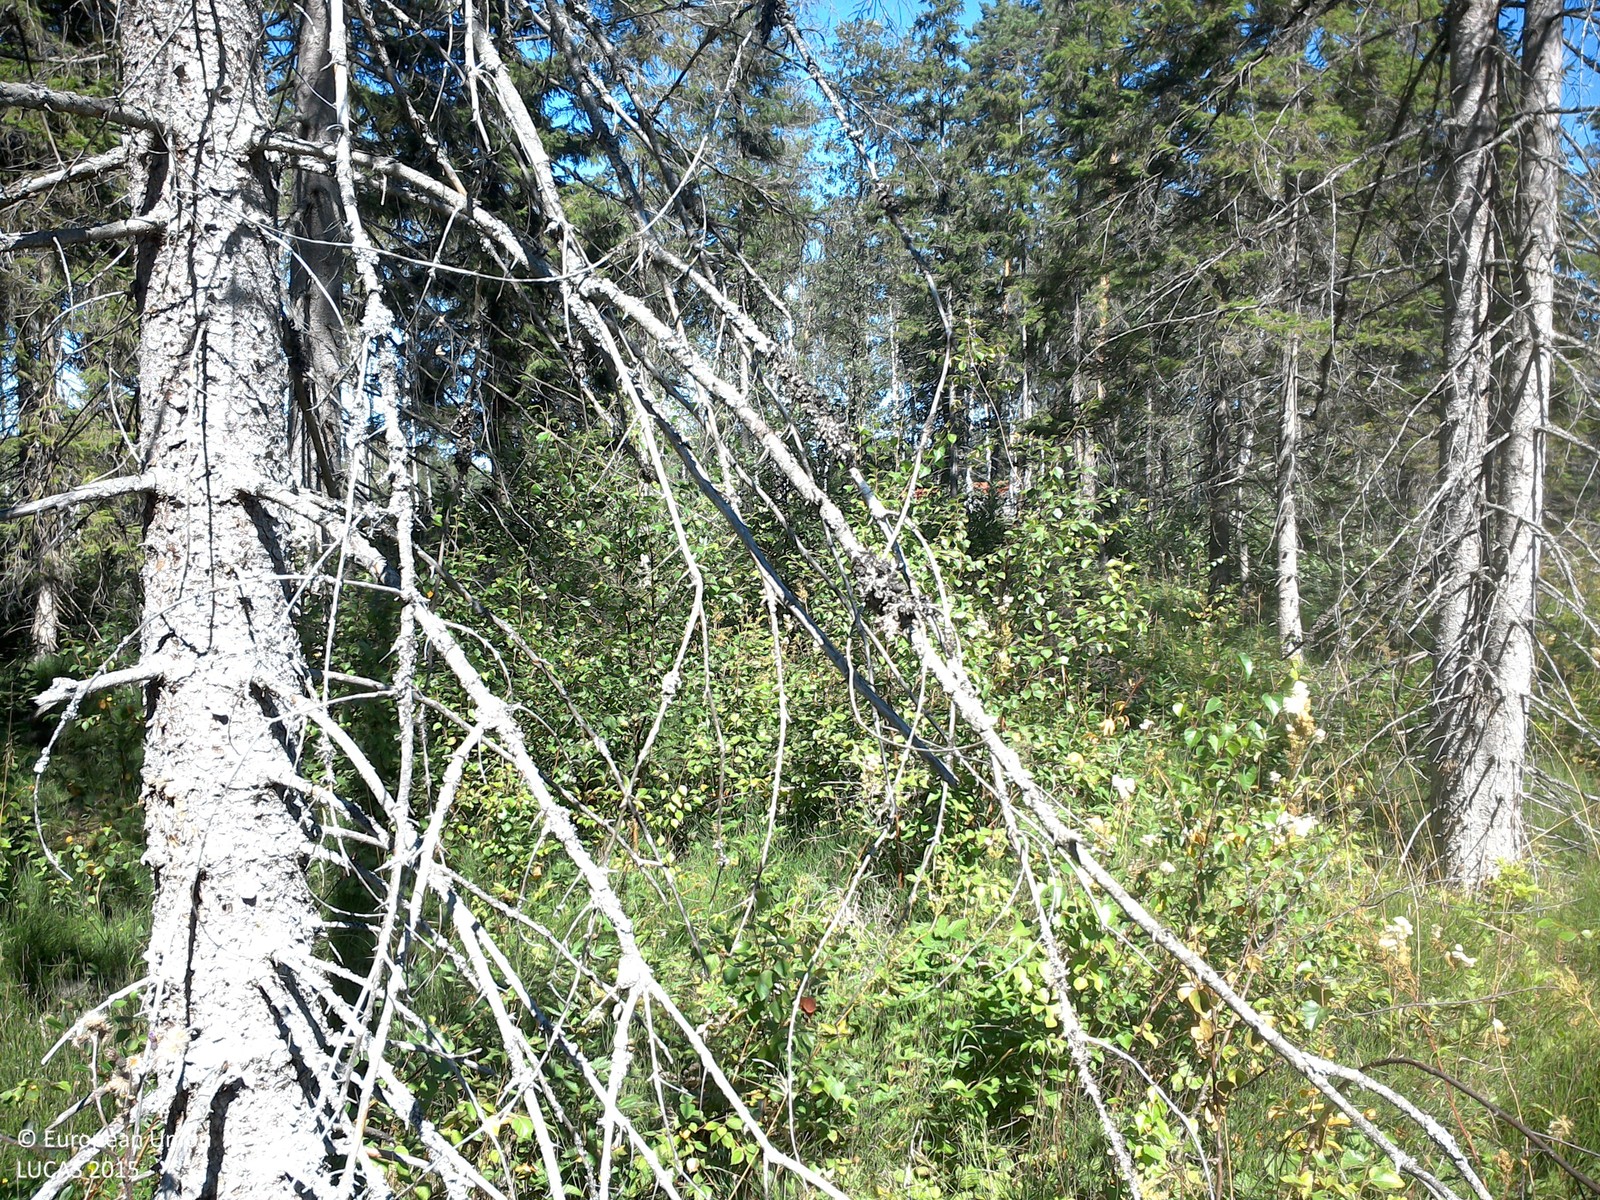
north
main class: Grassland
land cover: Spontaneously vegetated surfaces
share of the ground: > 75 %
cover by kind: herbaceous plants 95 %, shrubs 5 %
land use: Forestry
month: August
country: SE
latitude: 58.2866
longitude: 15.0598
